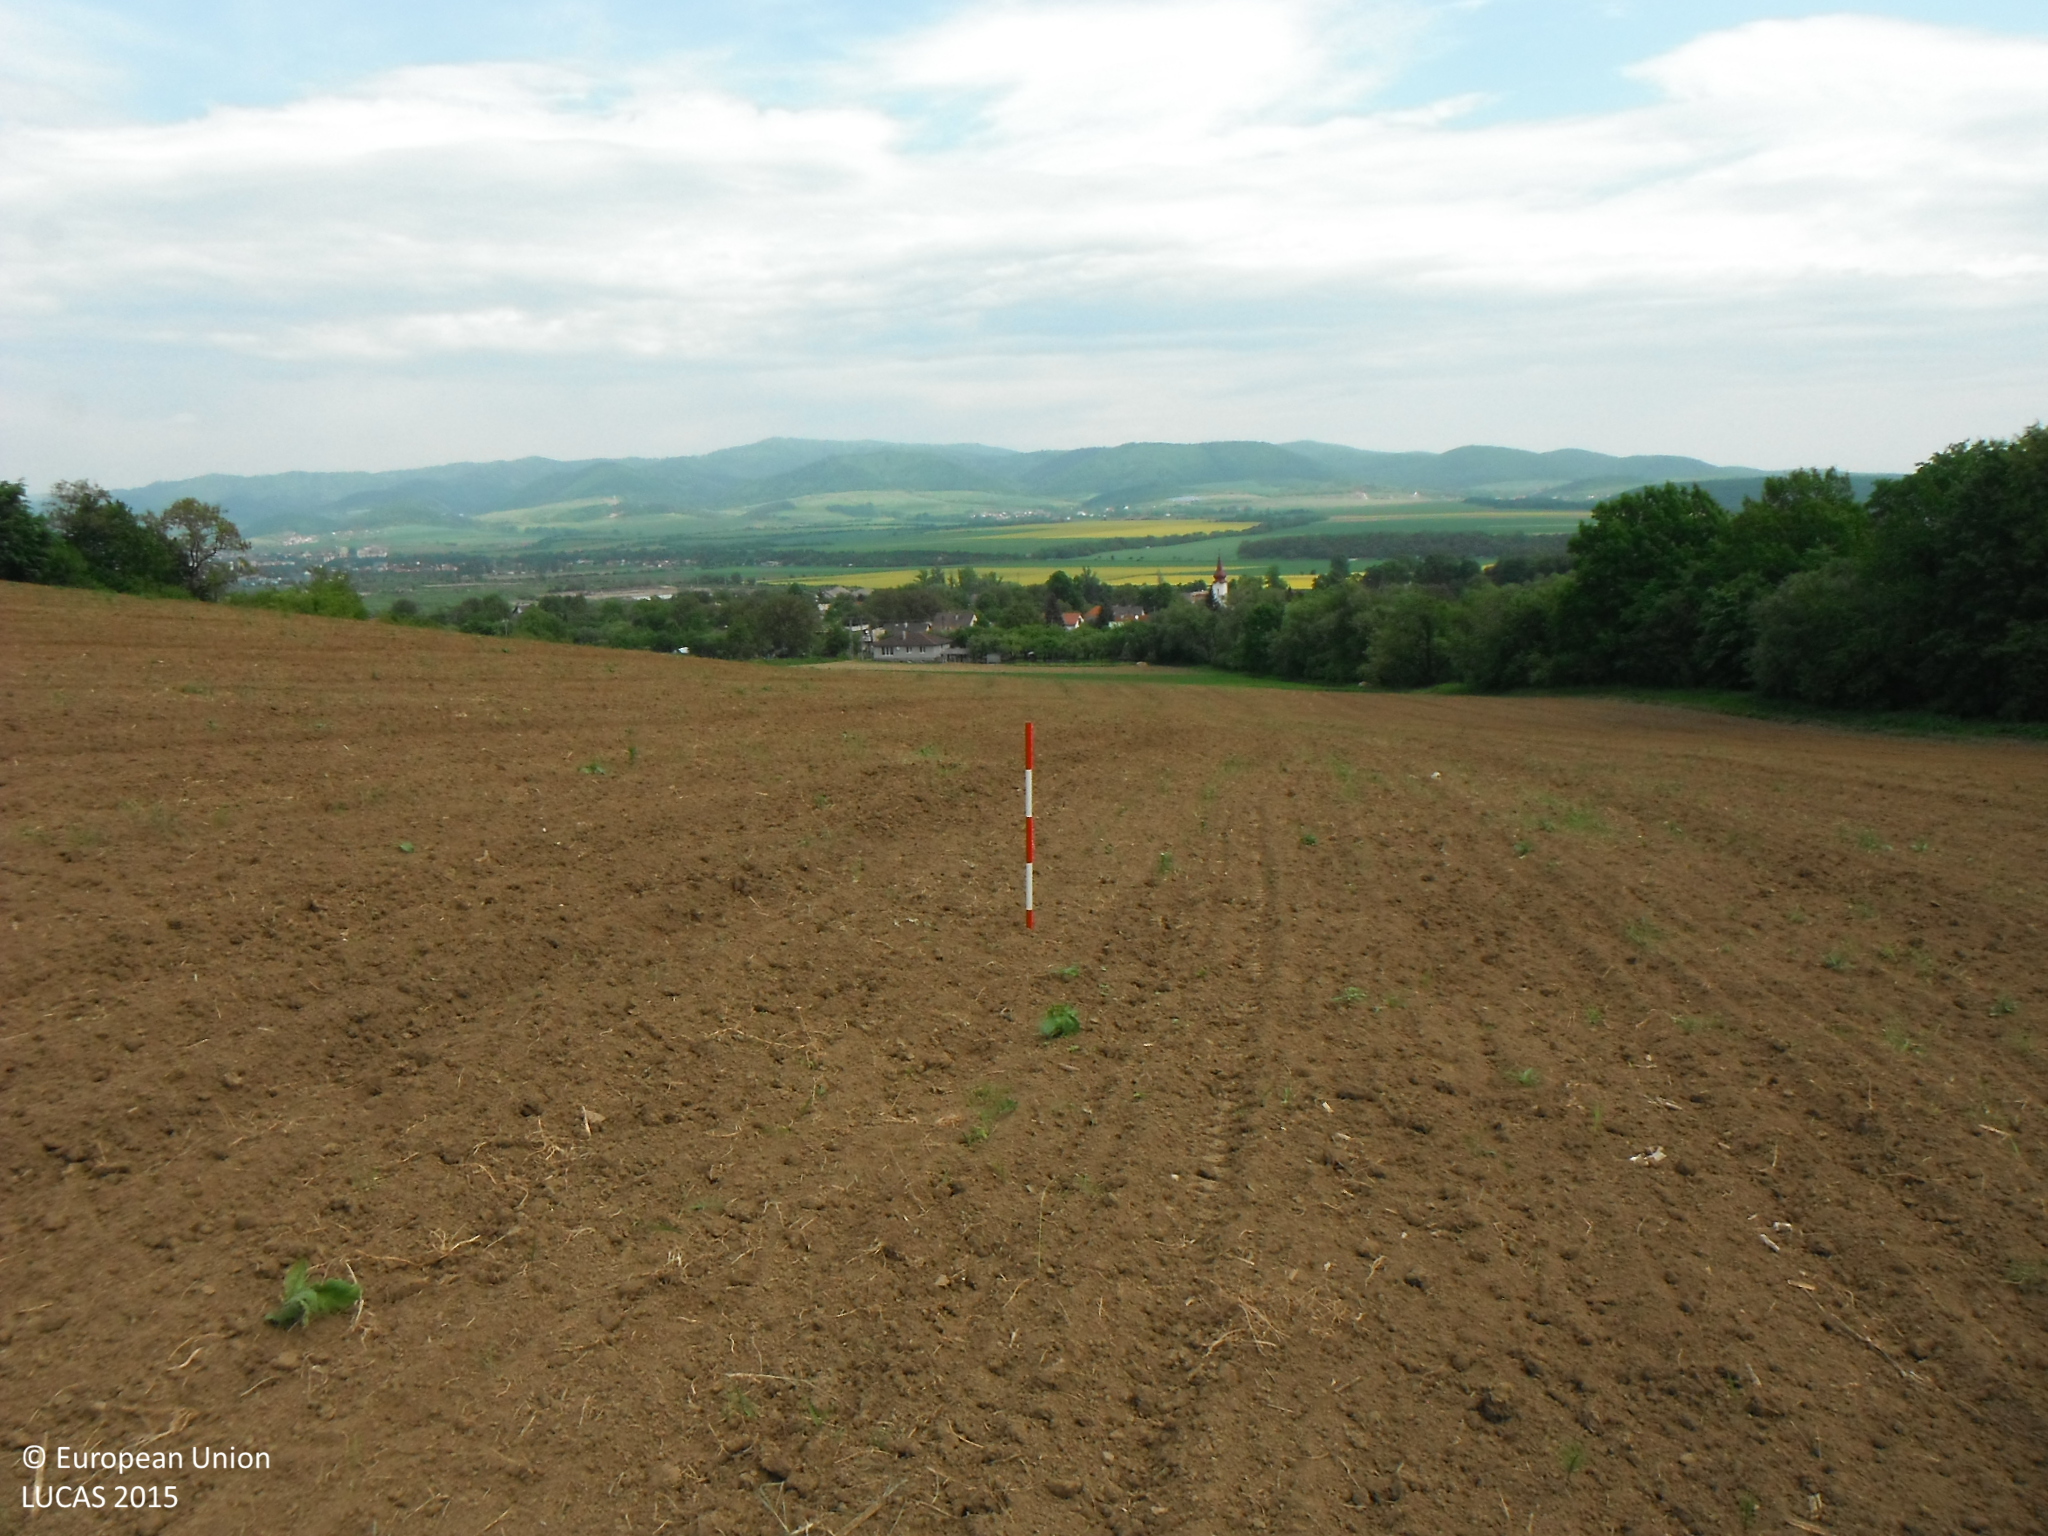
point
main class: Cropland
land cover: Other cereals
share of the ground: < 10 %
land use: Agriculture (excluding fallow land and kitchen gardens)
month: May
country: SK
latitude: 49.0579
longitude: 21.1145
